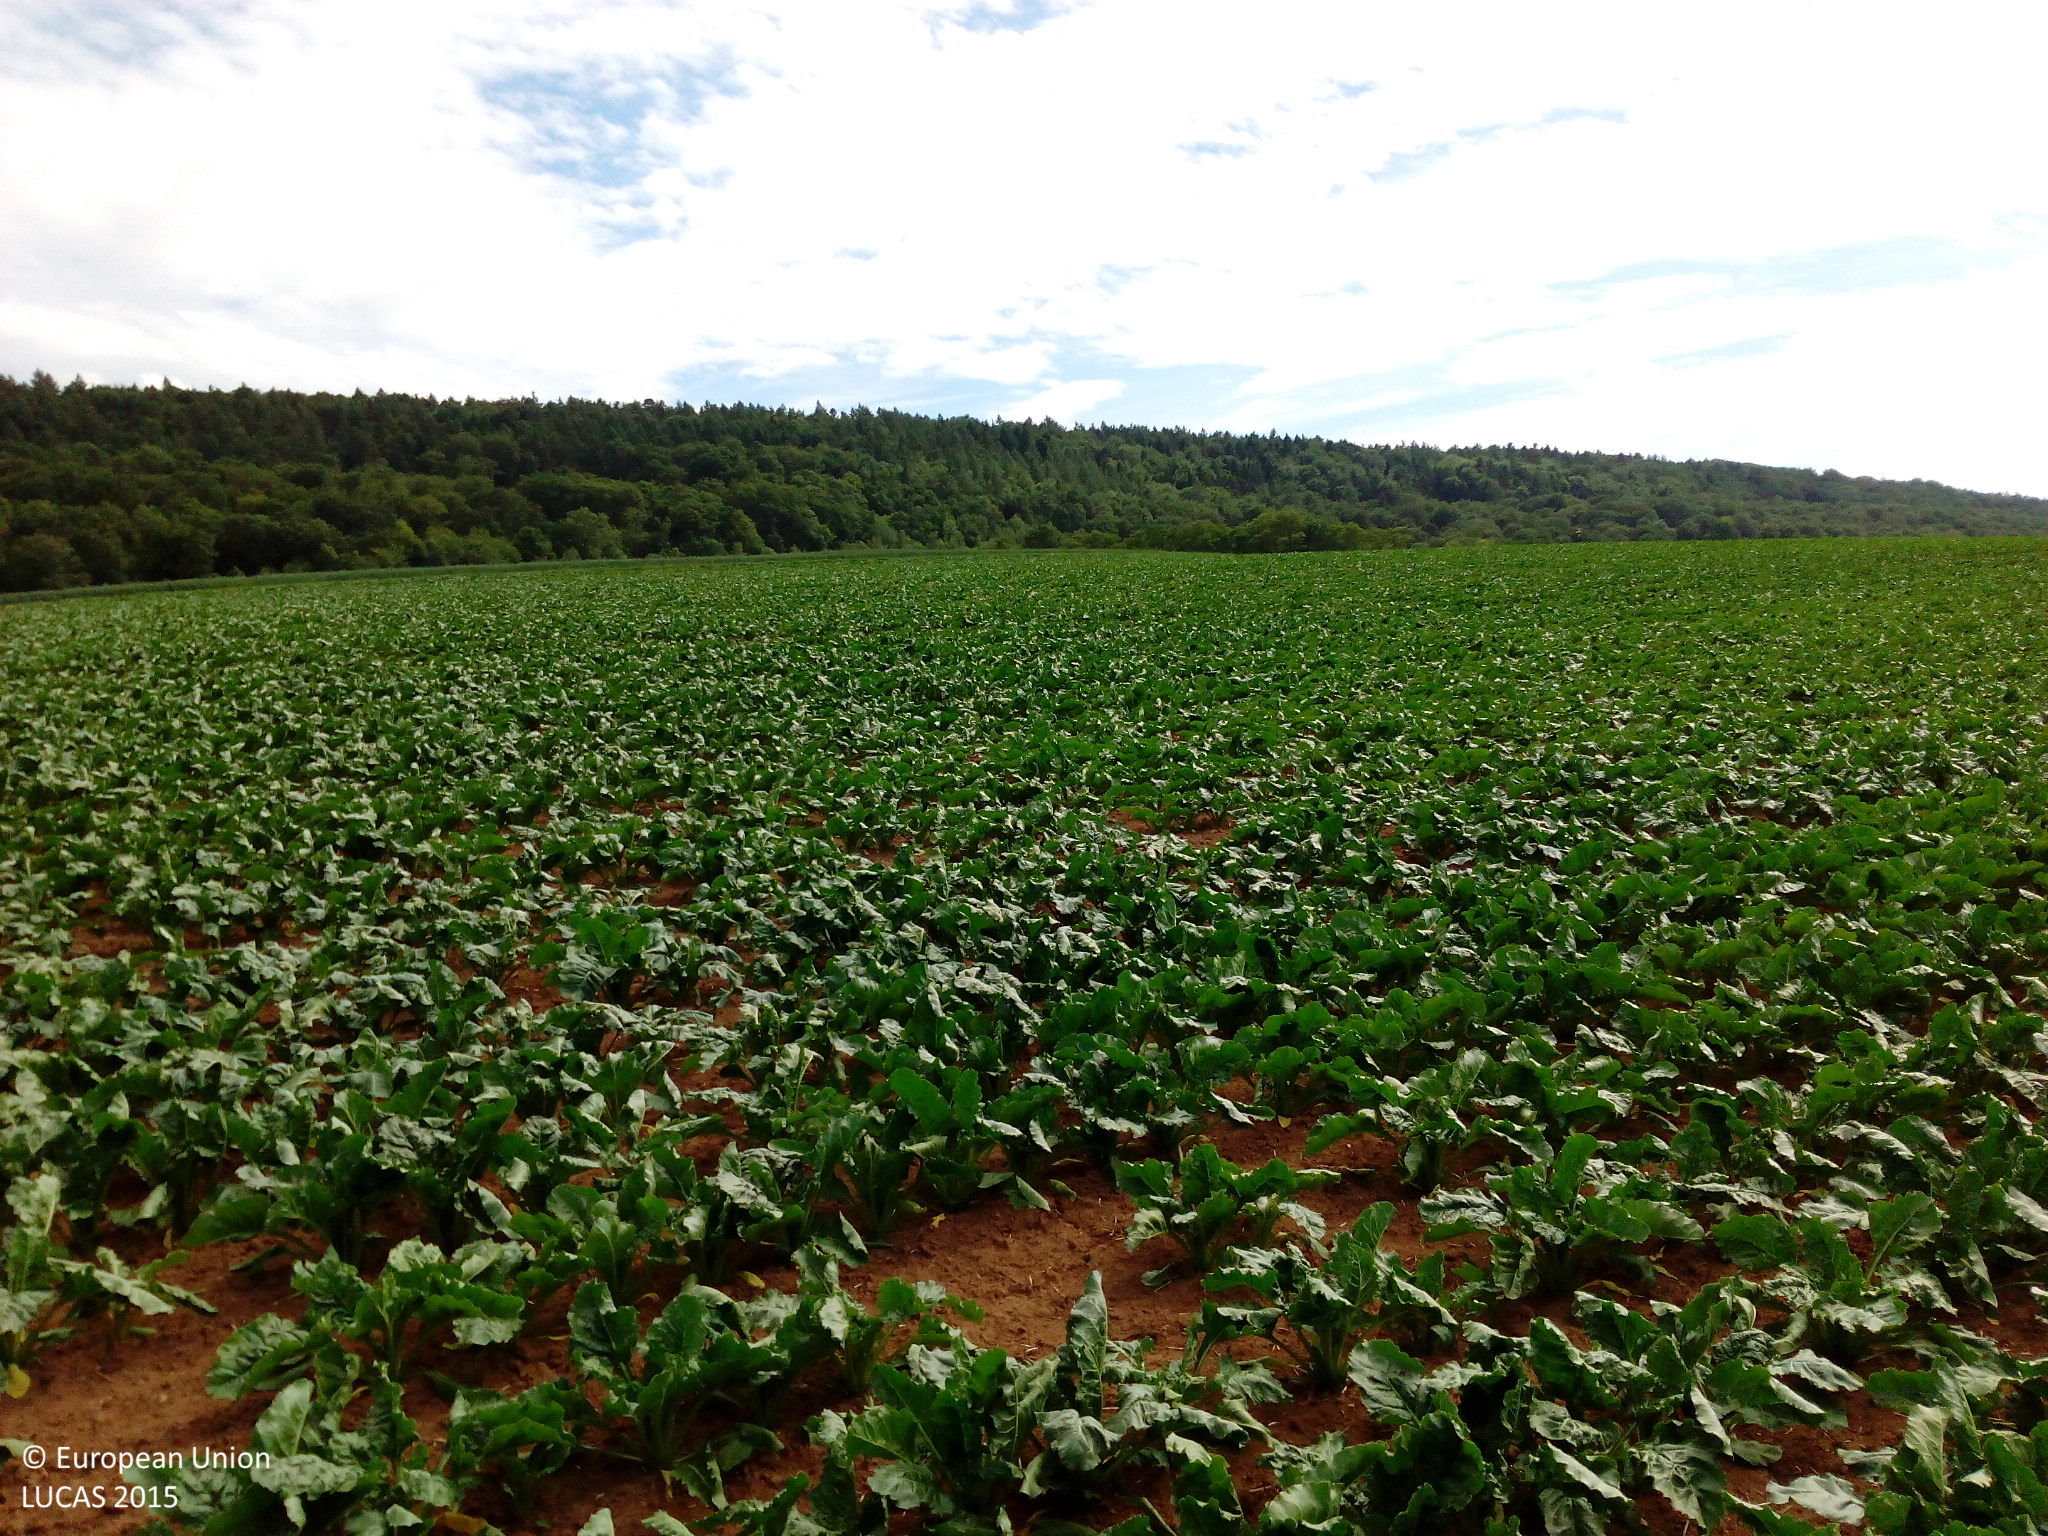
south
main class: Cropland
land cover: Sugar beet
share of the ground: > 75 %
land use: Agriculture (excluding fallow land and kitchen gardens)
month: June
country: DE
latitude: 49.1751
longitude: 9.3281
